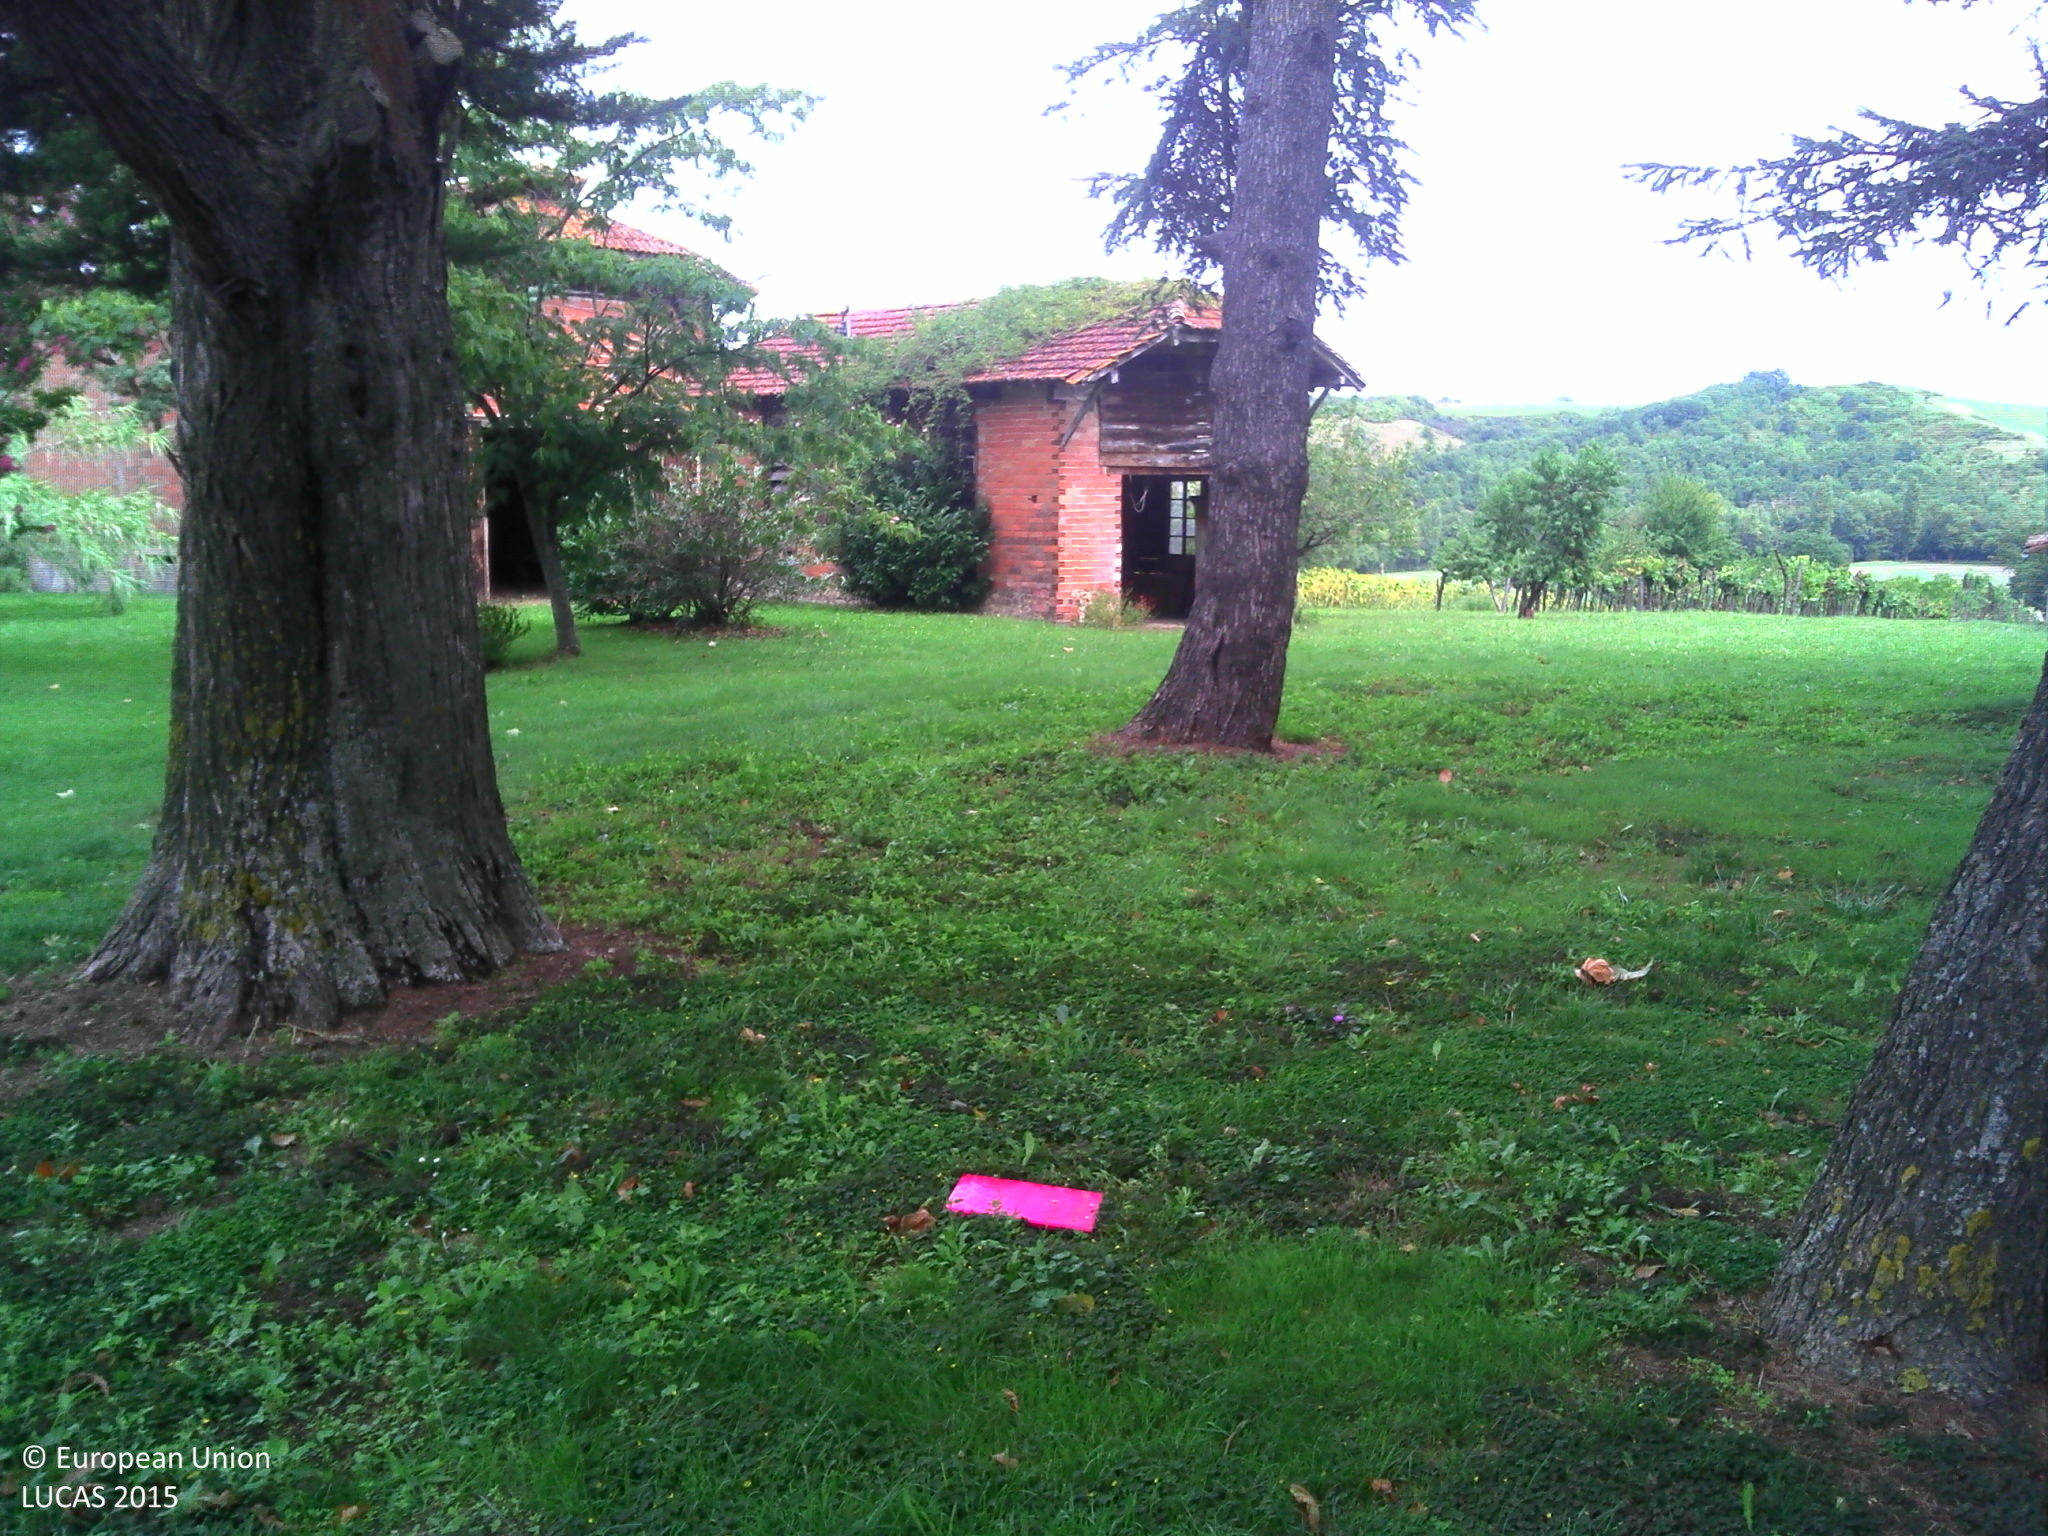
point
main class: Woodland
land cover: Pine dominated mixed woodland
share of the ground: > 75 %
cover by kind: coniferous forest trees 50 %, broadleaved forest trees 25 %, herbaceous plants 25 %
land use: Residential
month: August
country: FR
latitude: 43.4081
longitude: 0.7261
